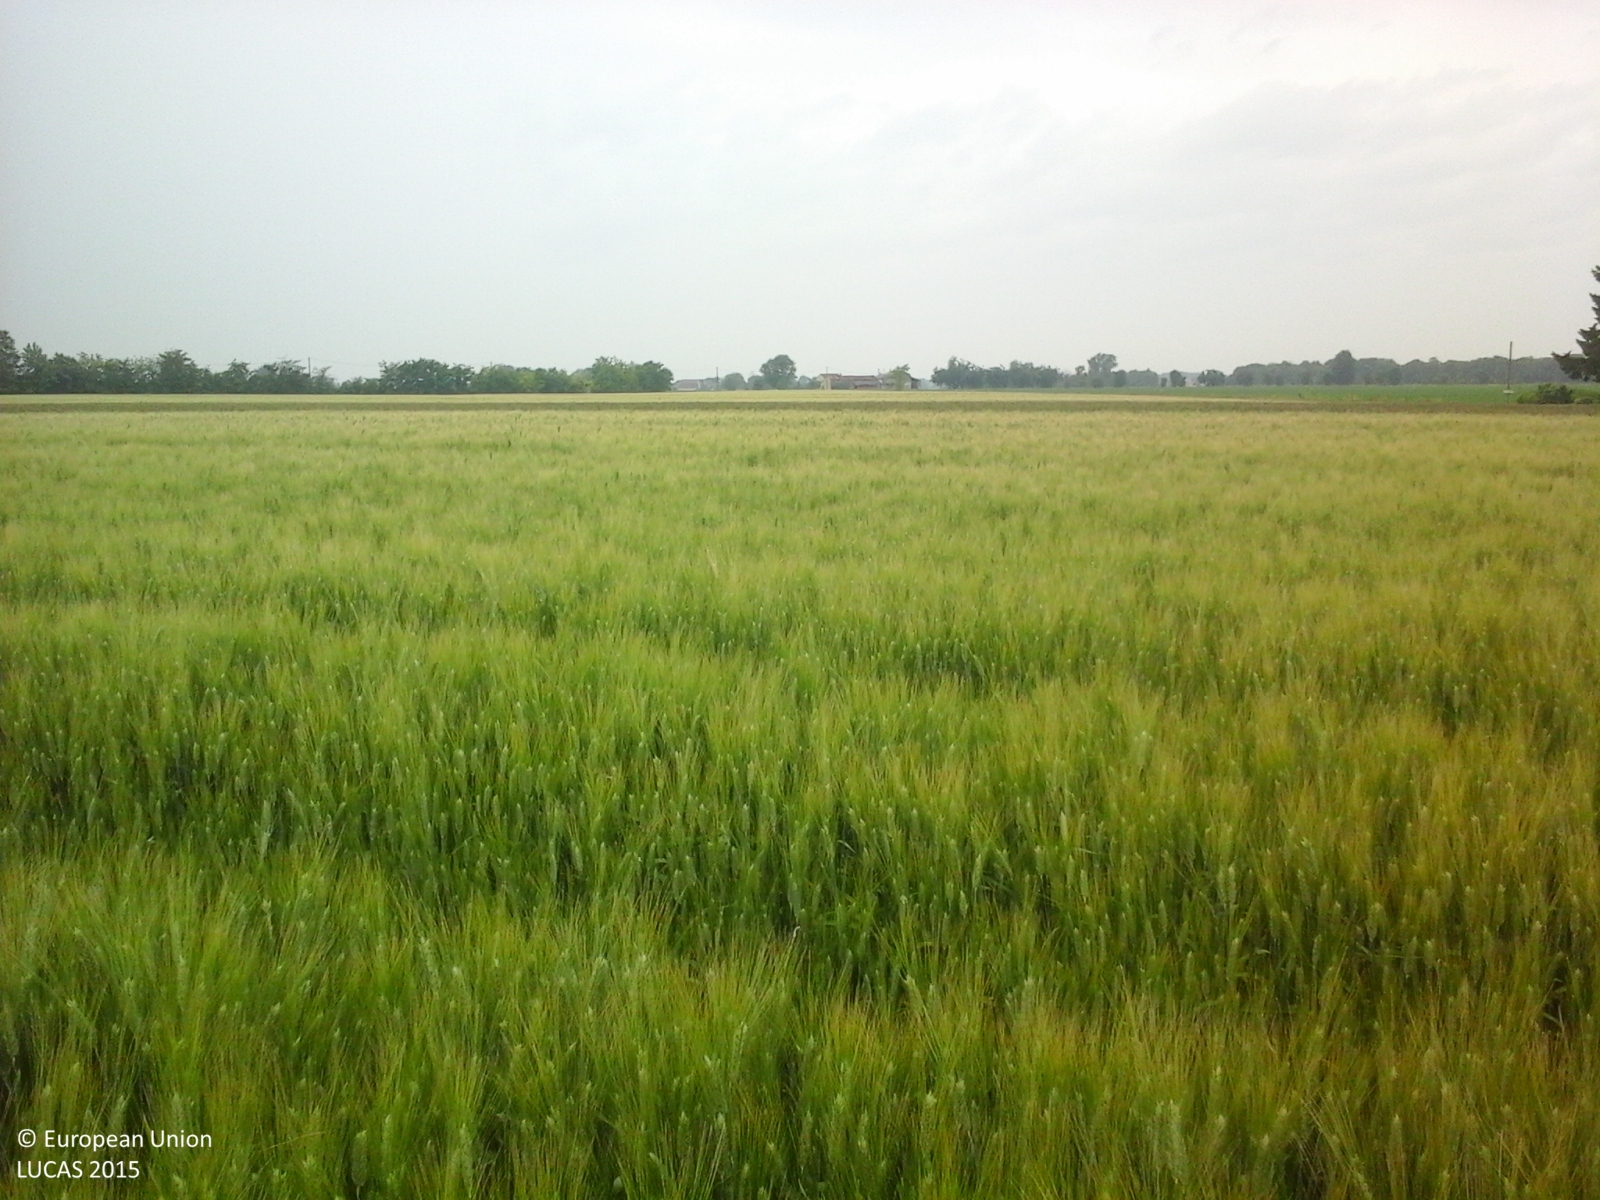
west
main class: Cropland
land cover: Common wheat
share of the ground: > 75 %
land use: Agriculture (excluding fallow land and kitchen gardens)
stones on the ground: < 10 %
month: May
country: IT
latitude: 45.1416
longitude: 10.6981
